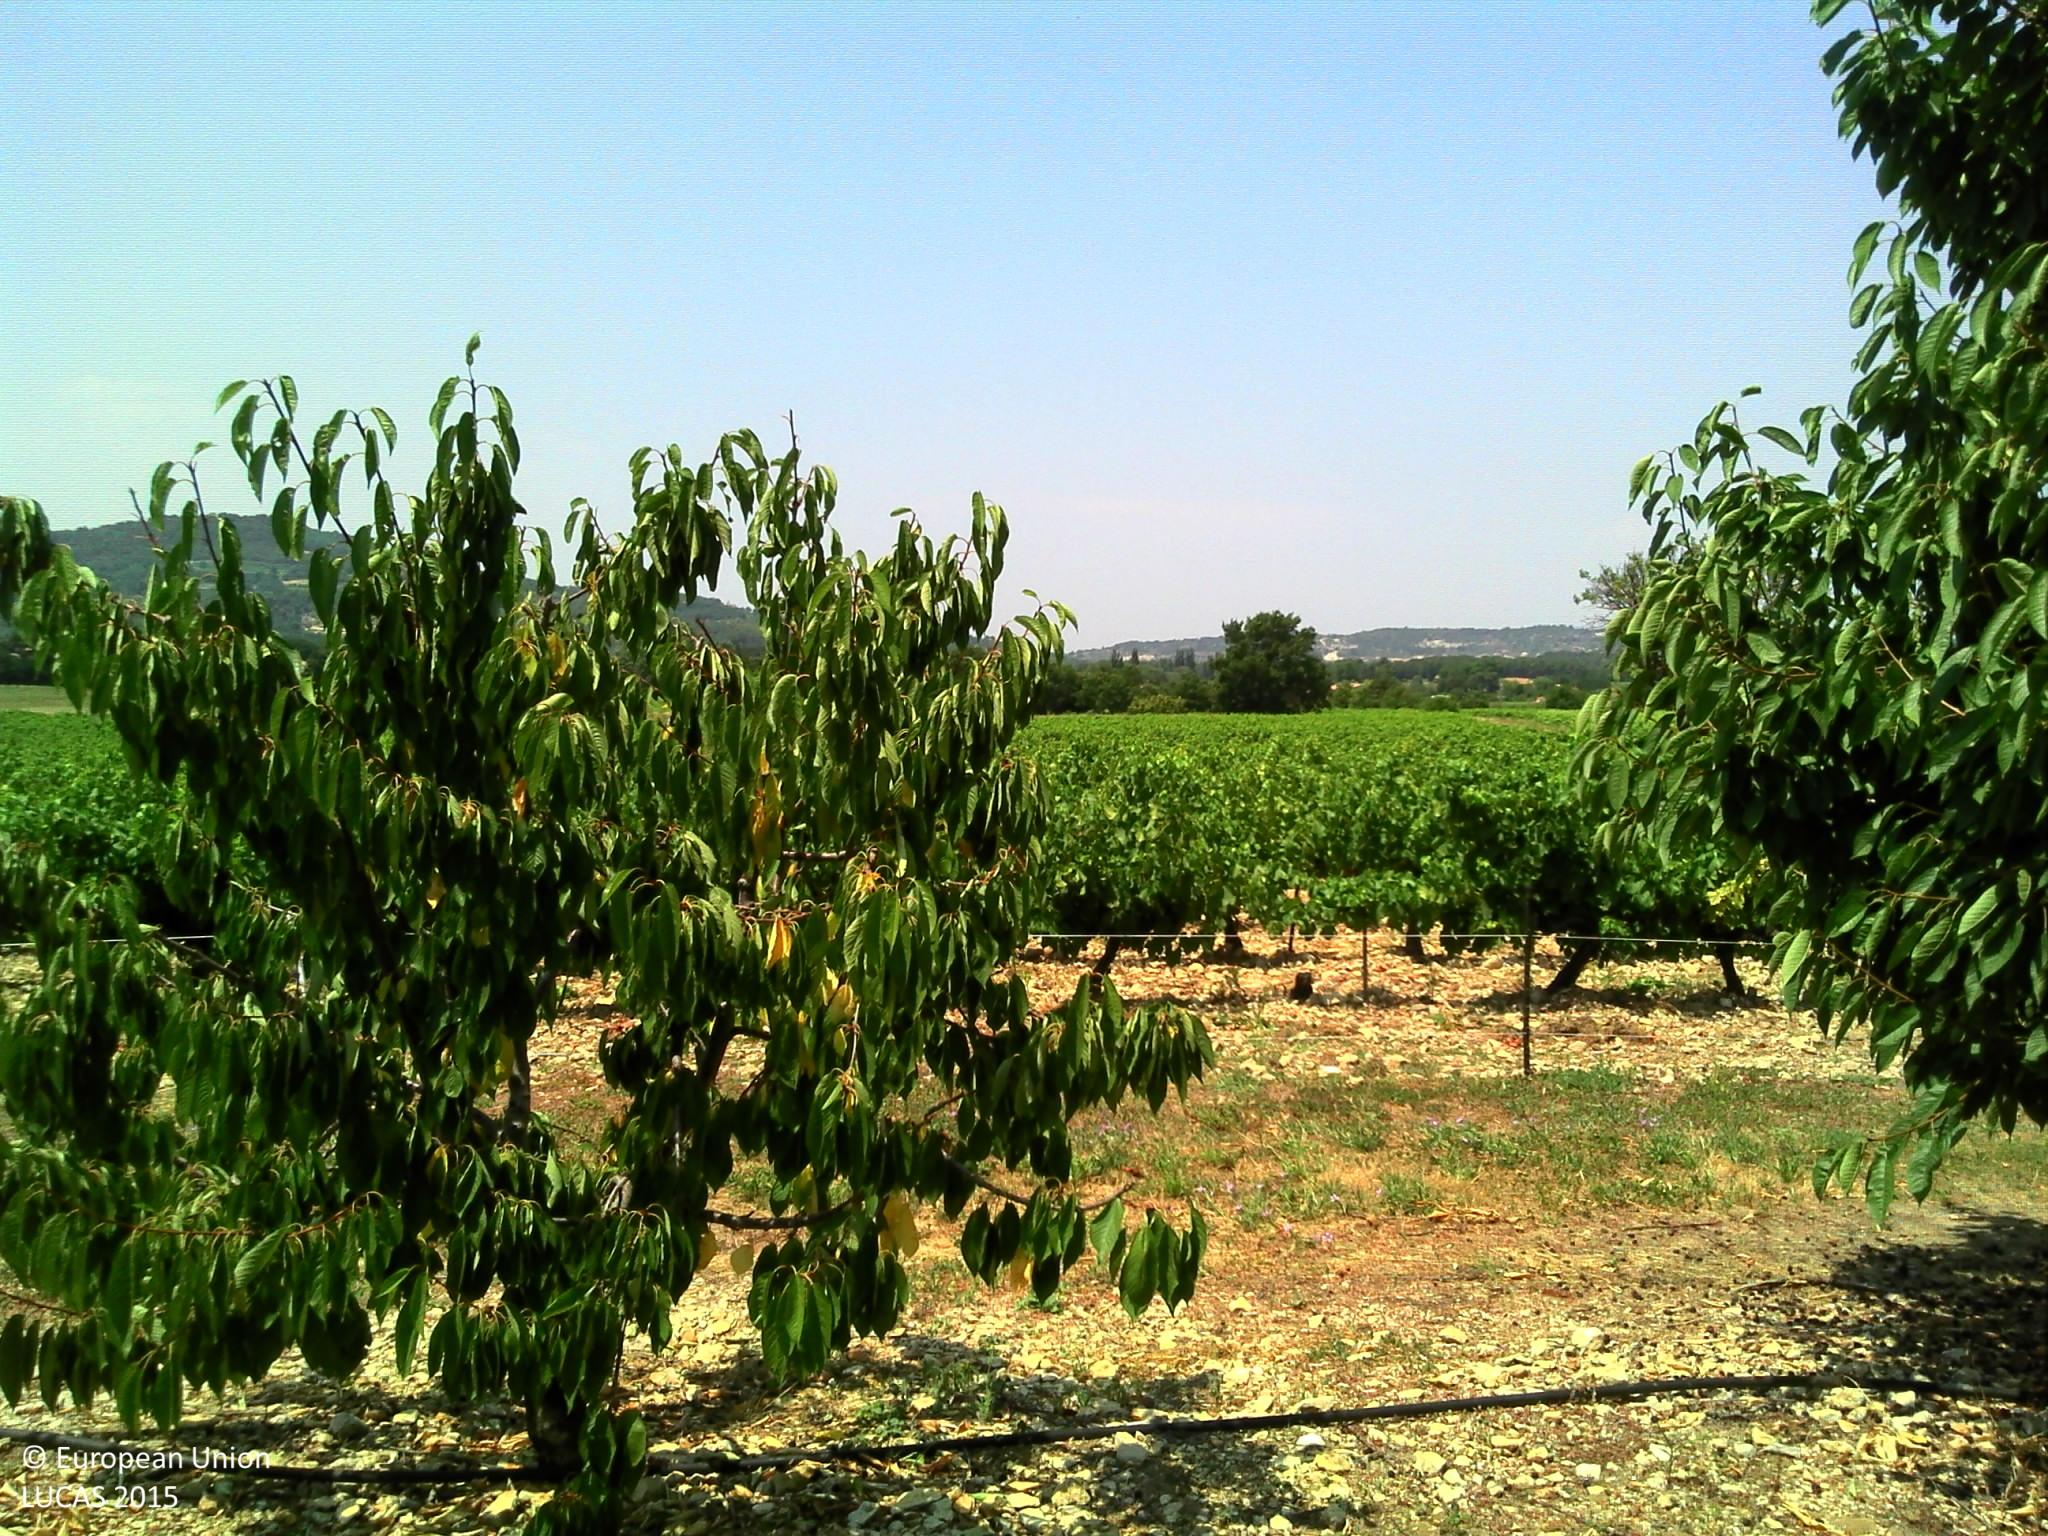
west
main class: Cropland
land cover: Cherry fruit
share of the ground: 50 - 75 %
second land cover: Grassland without tree/shrub cover
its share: 50 - 75 %
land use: Agriculture (excluding fallow land and kitchen gardens)
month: July
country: FR
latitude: 44.0421
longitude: 5.2286
